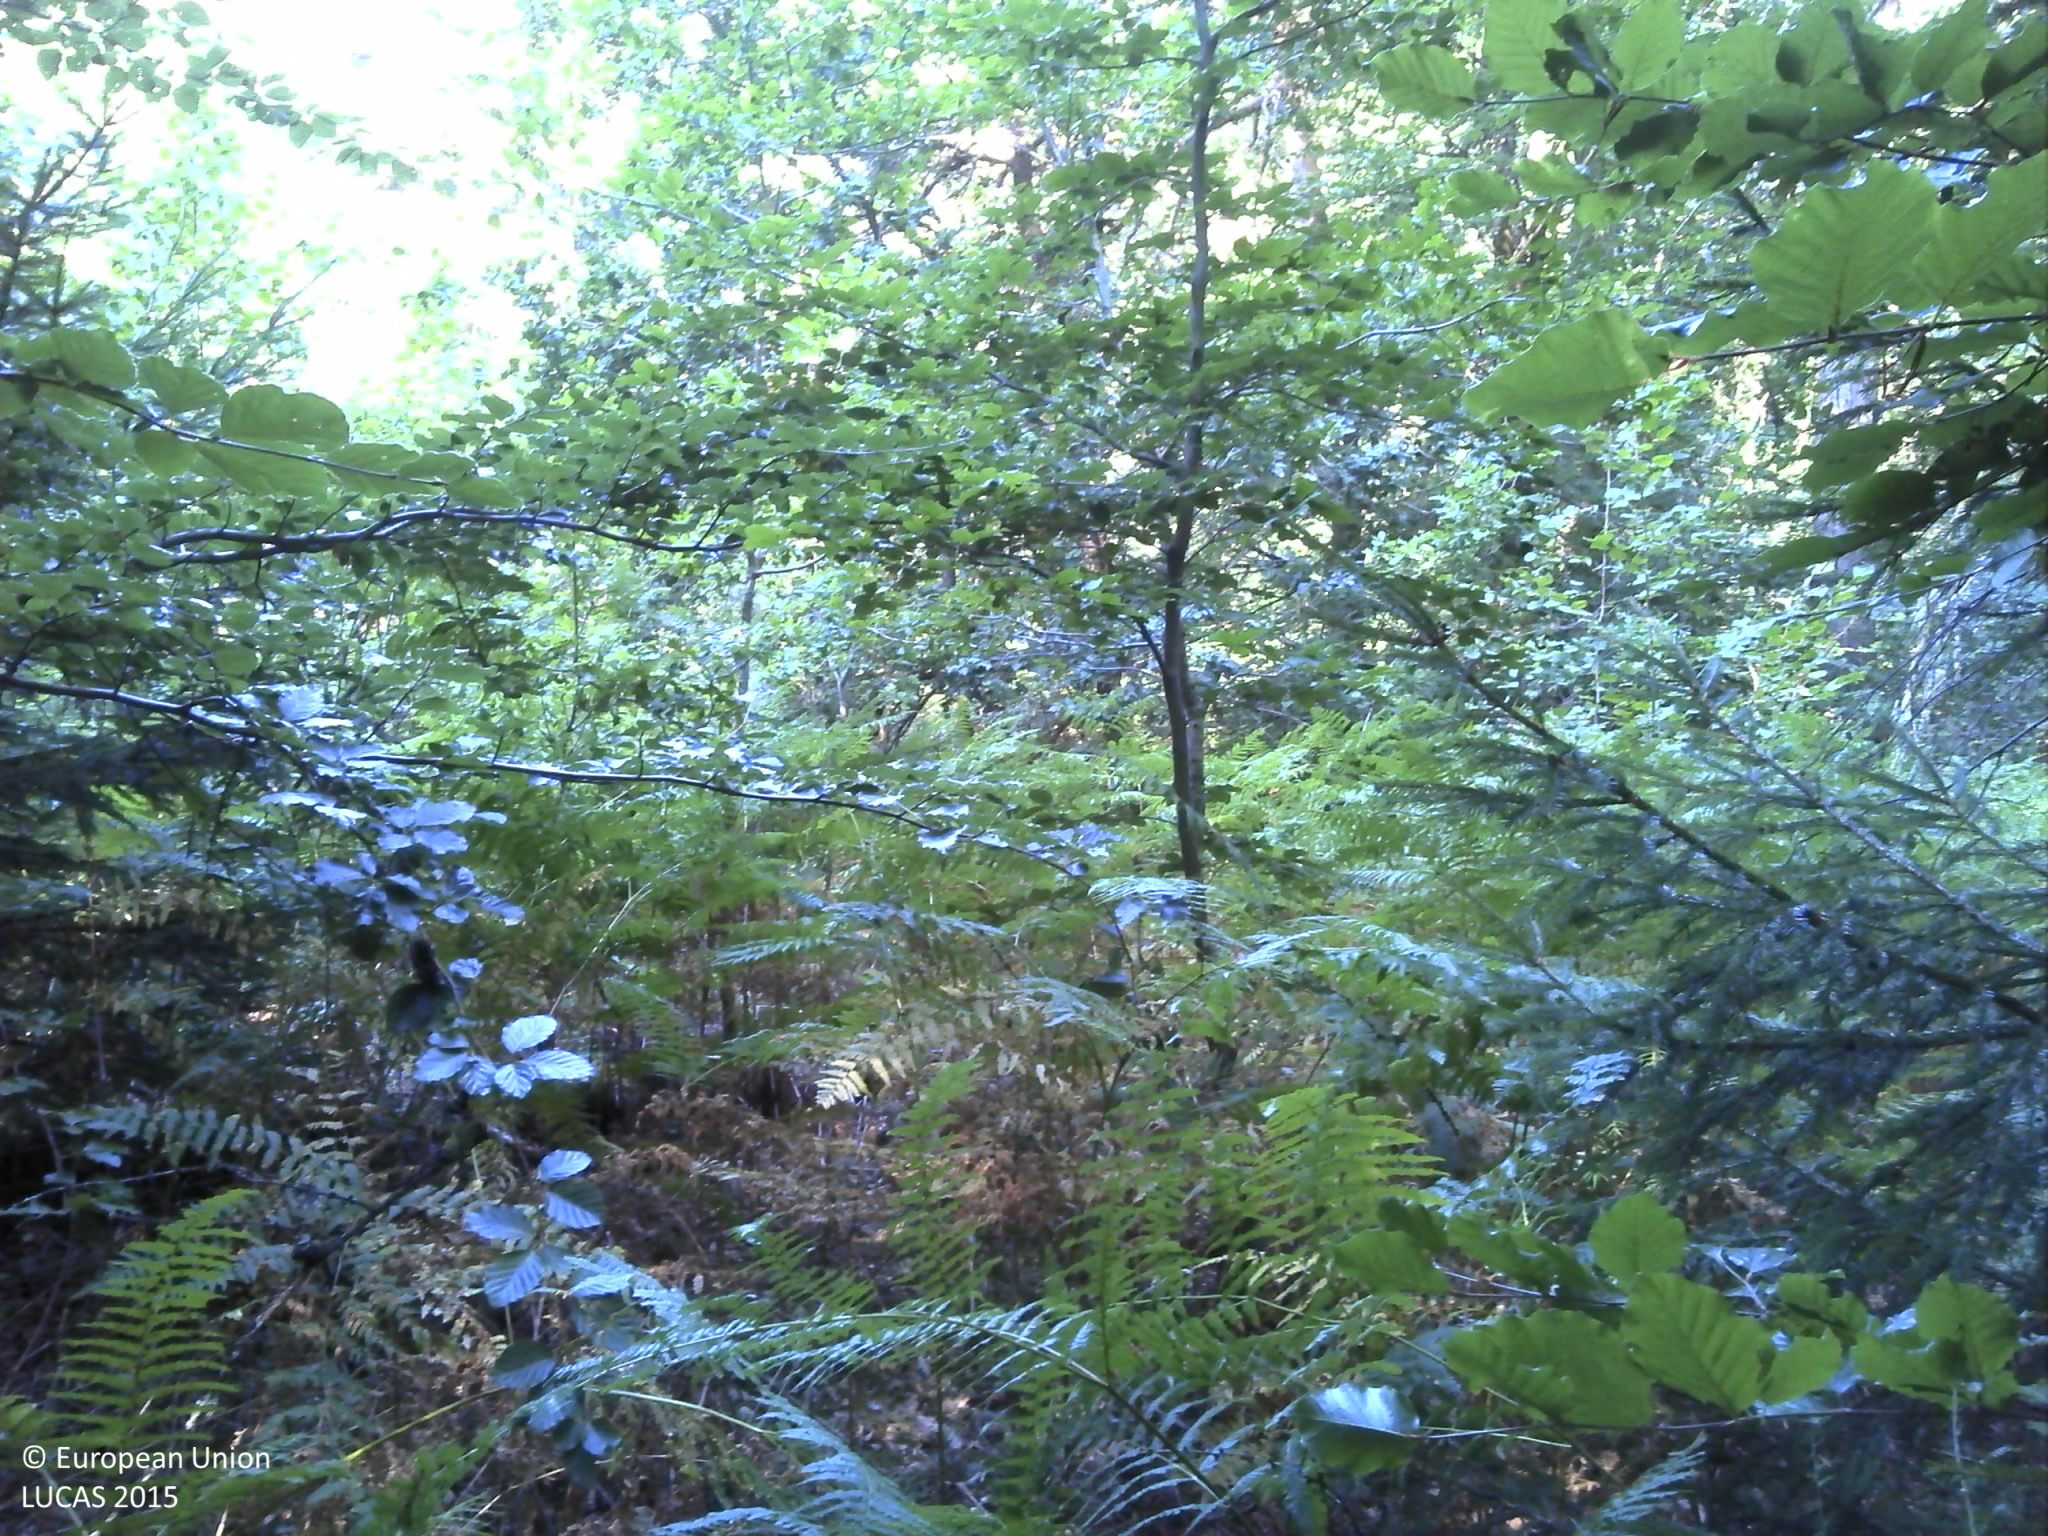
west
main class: Woodland
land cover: Other mixed woodland
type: mountainous beech forest
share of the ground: > 75 %
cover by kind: broadleaved forest trees 40 %, coniferous forest trees 30 %, unconsolidated bare surface 20 %, herbaceous plants 5 %, lichens and mosses 5 %
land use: Forestry
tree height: > 5 m
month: August
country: FR
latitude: 45.4665
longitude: 2.4138
